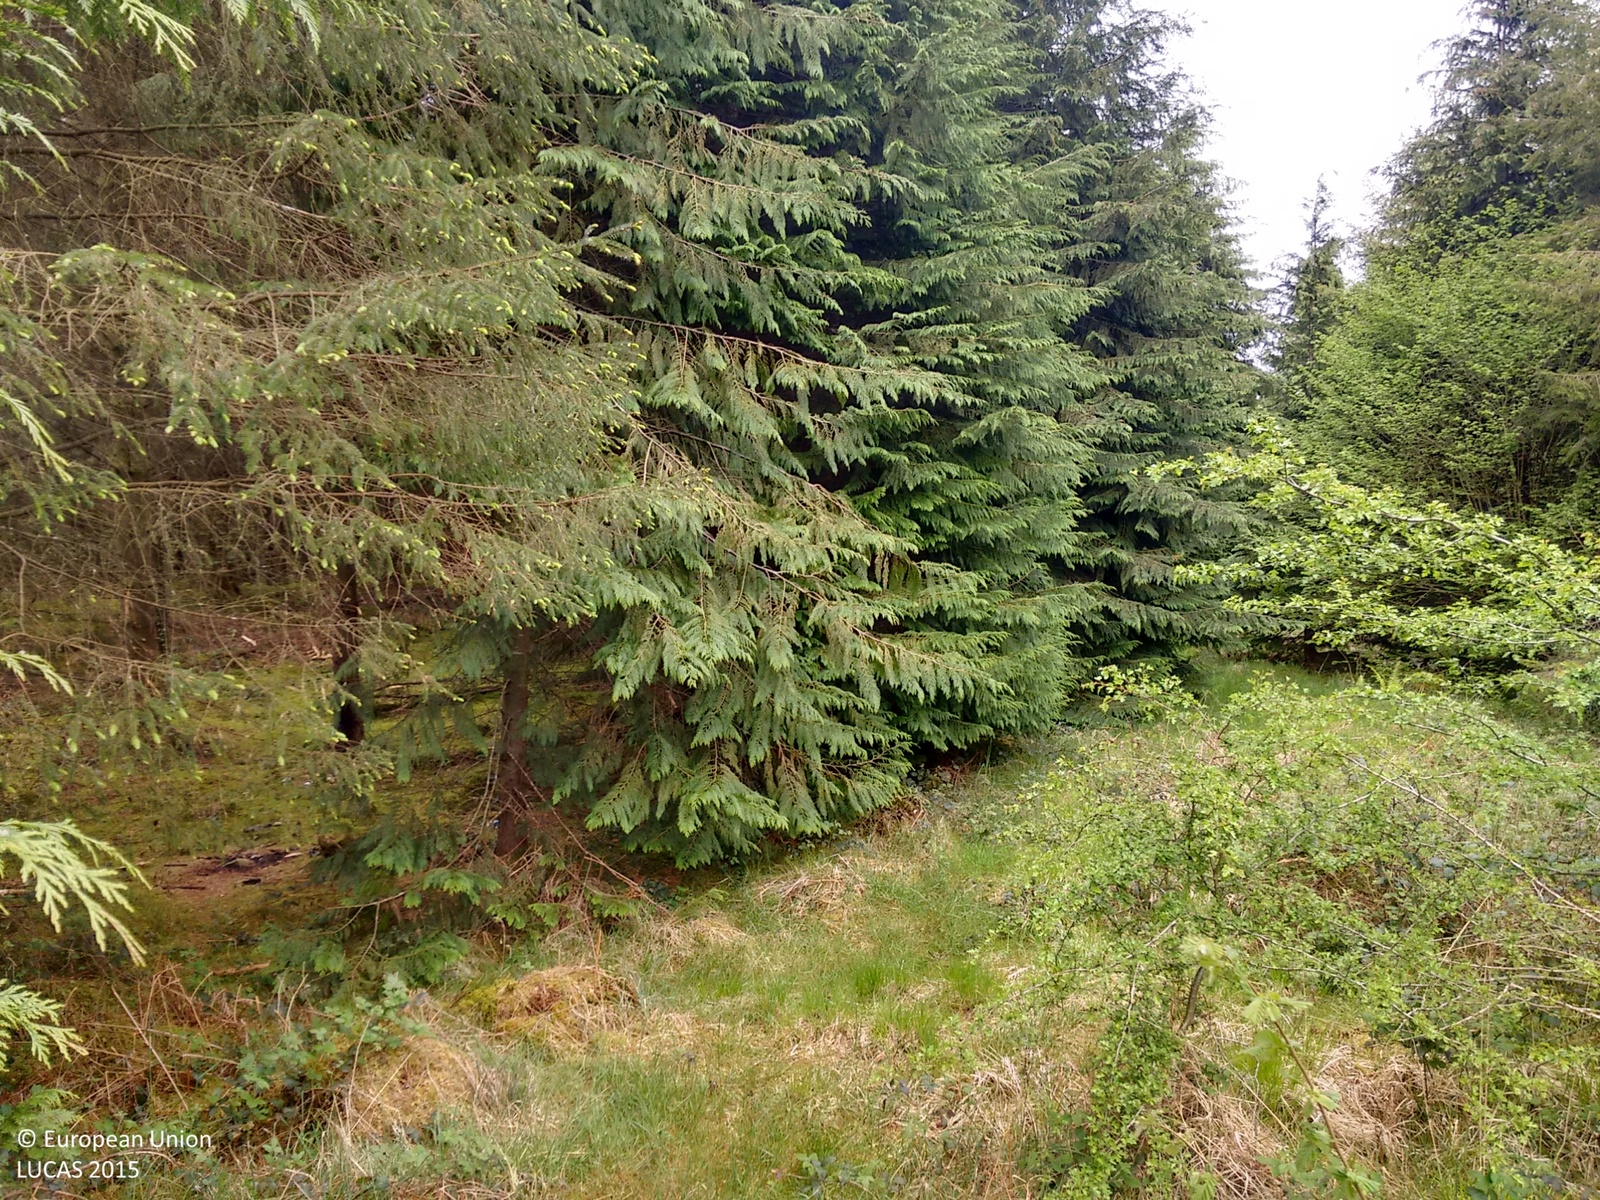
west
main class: Woodland
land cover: Spruce dominated coniferous woodland
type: boreal forest
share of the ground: > 75 %
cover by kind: coniferous forest trees 75 %, shrubs 10 %, herbaceous plants 10 %, broadleaved forest trees 5 %
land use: Forestry
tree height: > 5 m
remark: Fire break
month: May
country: IE
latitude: 53.3458
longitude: -8.7227
